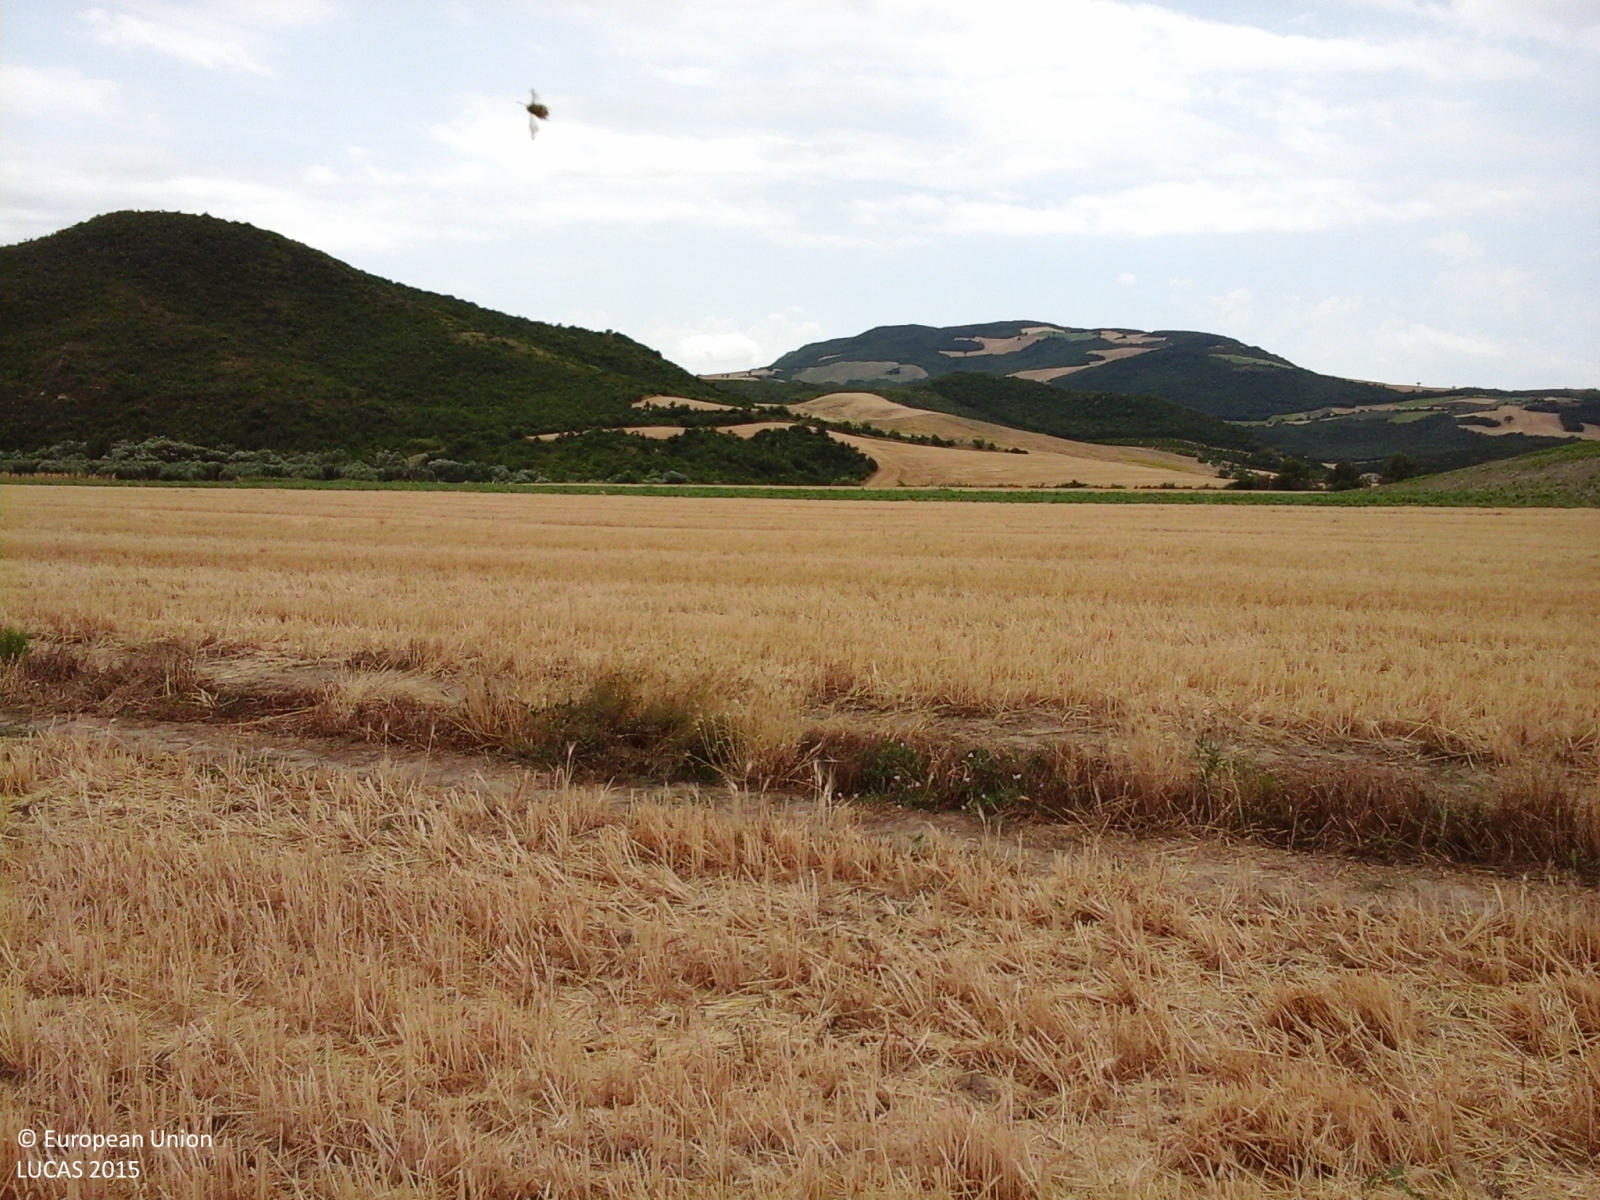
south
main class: Cropland
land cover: Durum wheat
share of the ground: > 75 %
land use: Agriculture (excluding fallow land and kitchen gardens)
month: June
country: IT
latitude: 41.6418
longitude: 15.0378
